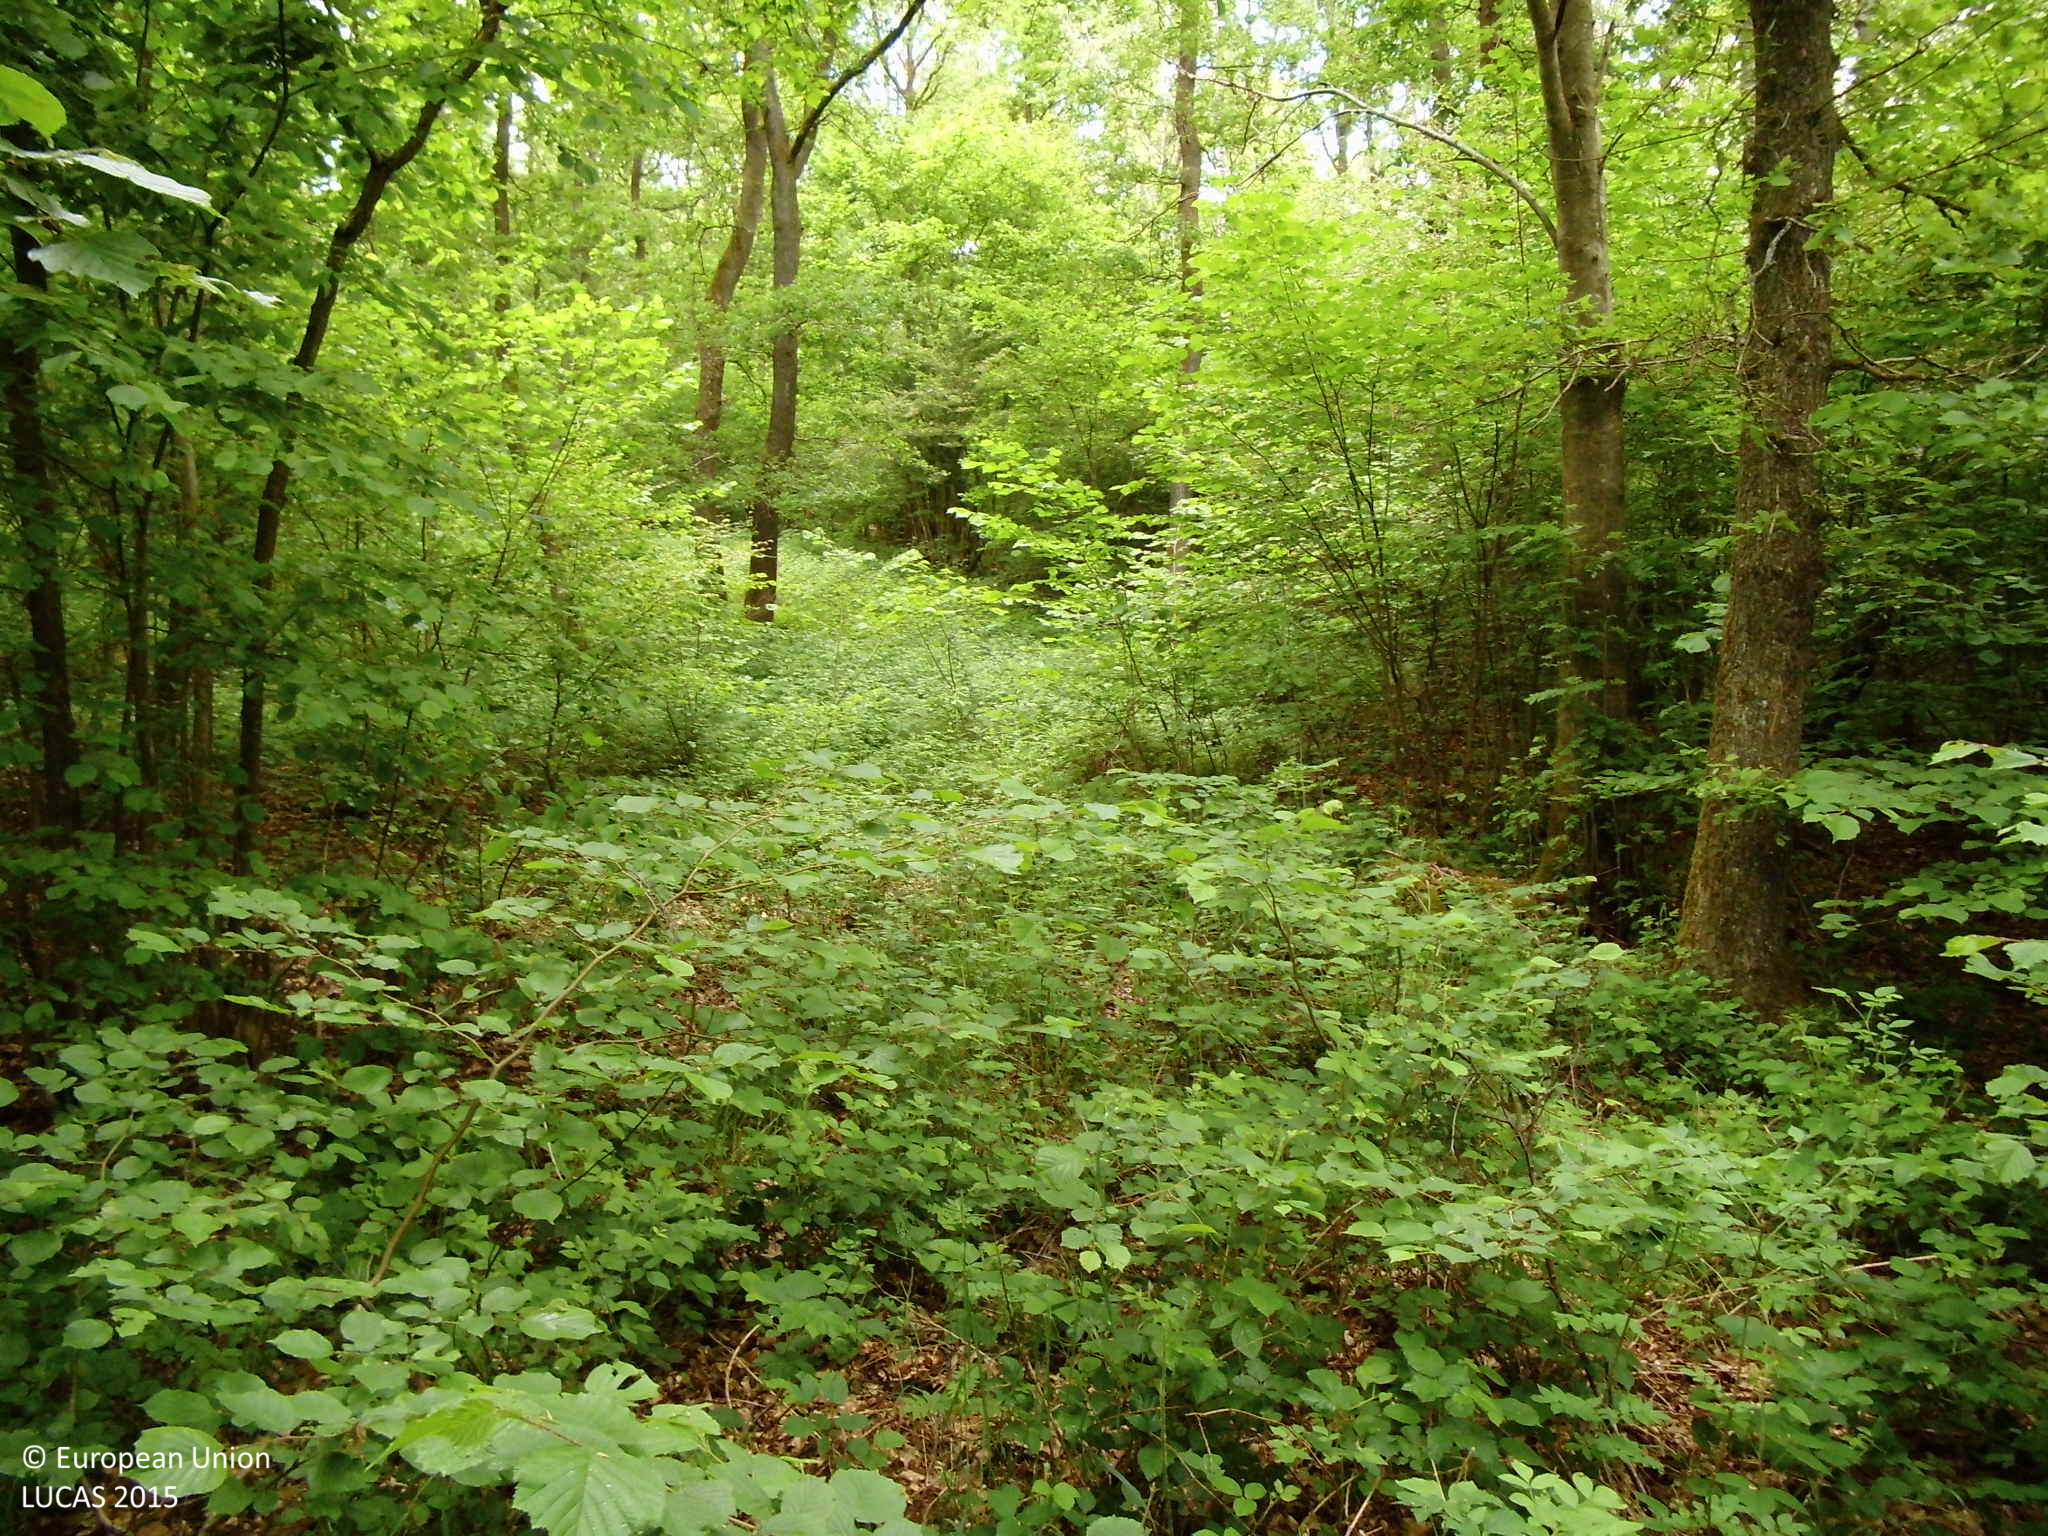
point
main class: Woodland
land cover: Broadleaved woodland
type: mesophytic deciduous forest
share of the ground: > 75 %
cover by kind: broadleaved forest trees 85 %, shrubs 10 %, herbaceous plants 5 %
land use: Forestry
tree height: > 5 m
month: June
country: DE
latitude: 51.0663
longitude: 8.0168
